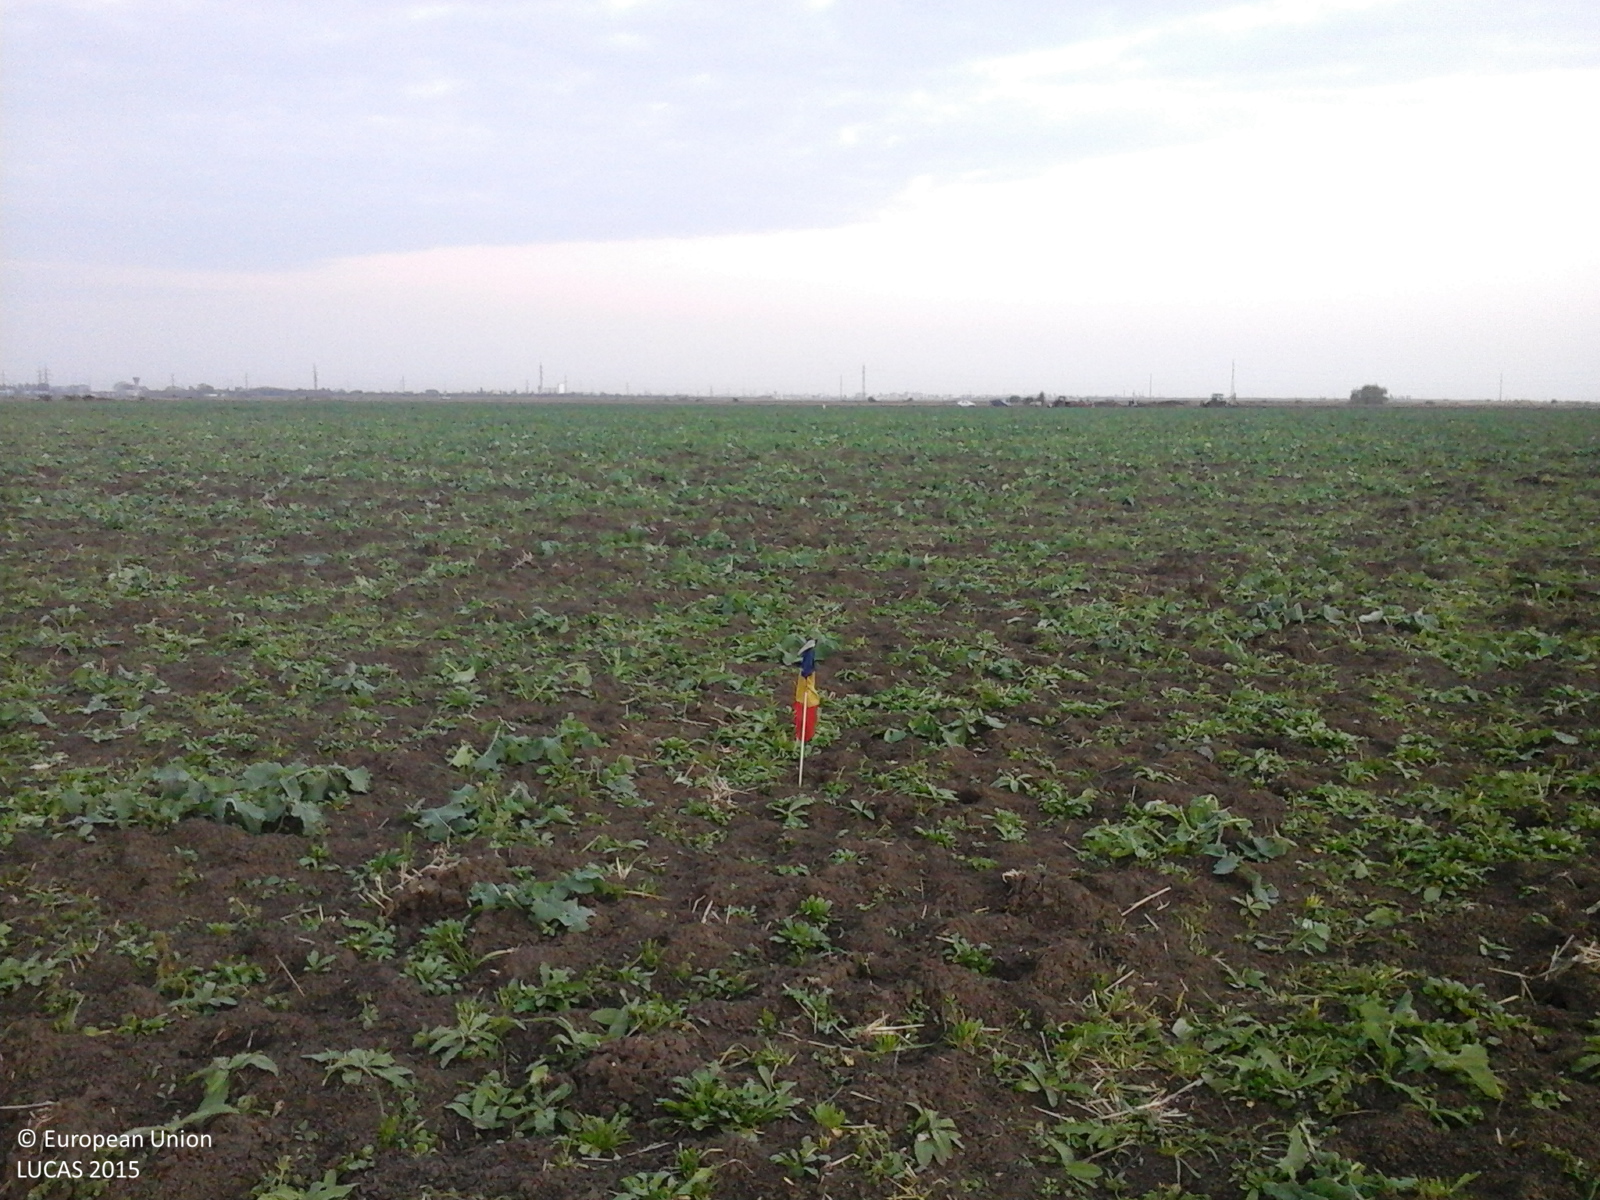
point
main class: Cropland
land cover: Rape and turnip rape
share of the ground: 50 - 75 %
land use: Agriculture (excluding fallow land and kitchen gardens)
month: October
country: RO
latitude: 45.1682
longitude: 26.7322
